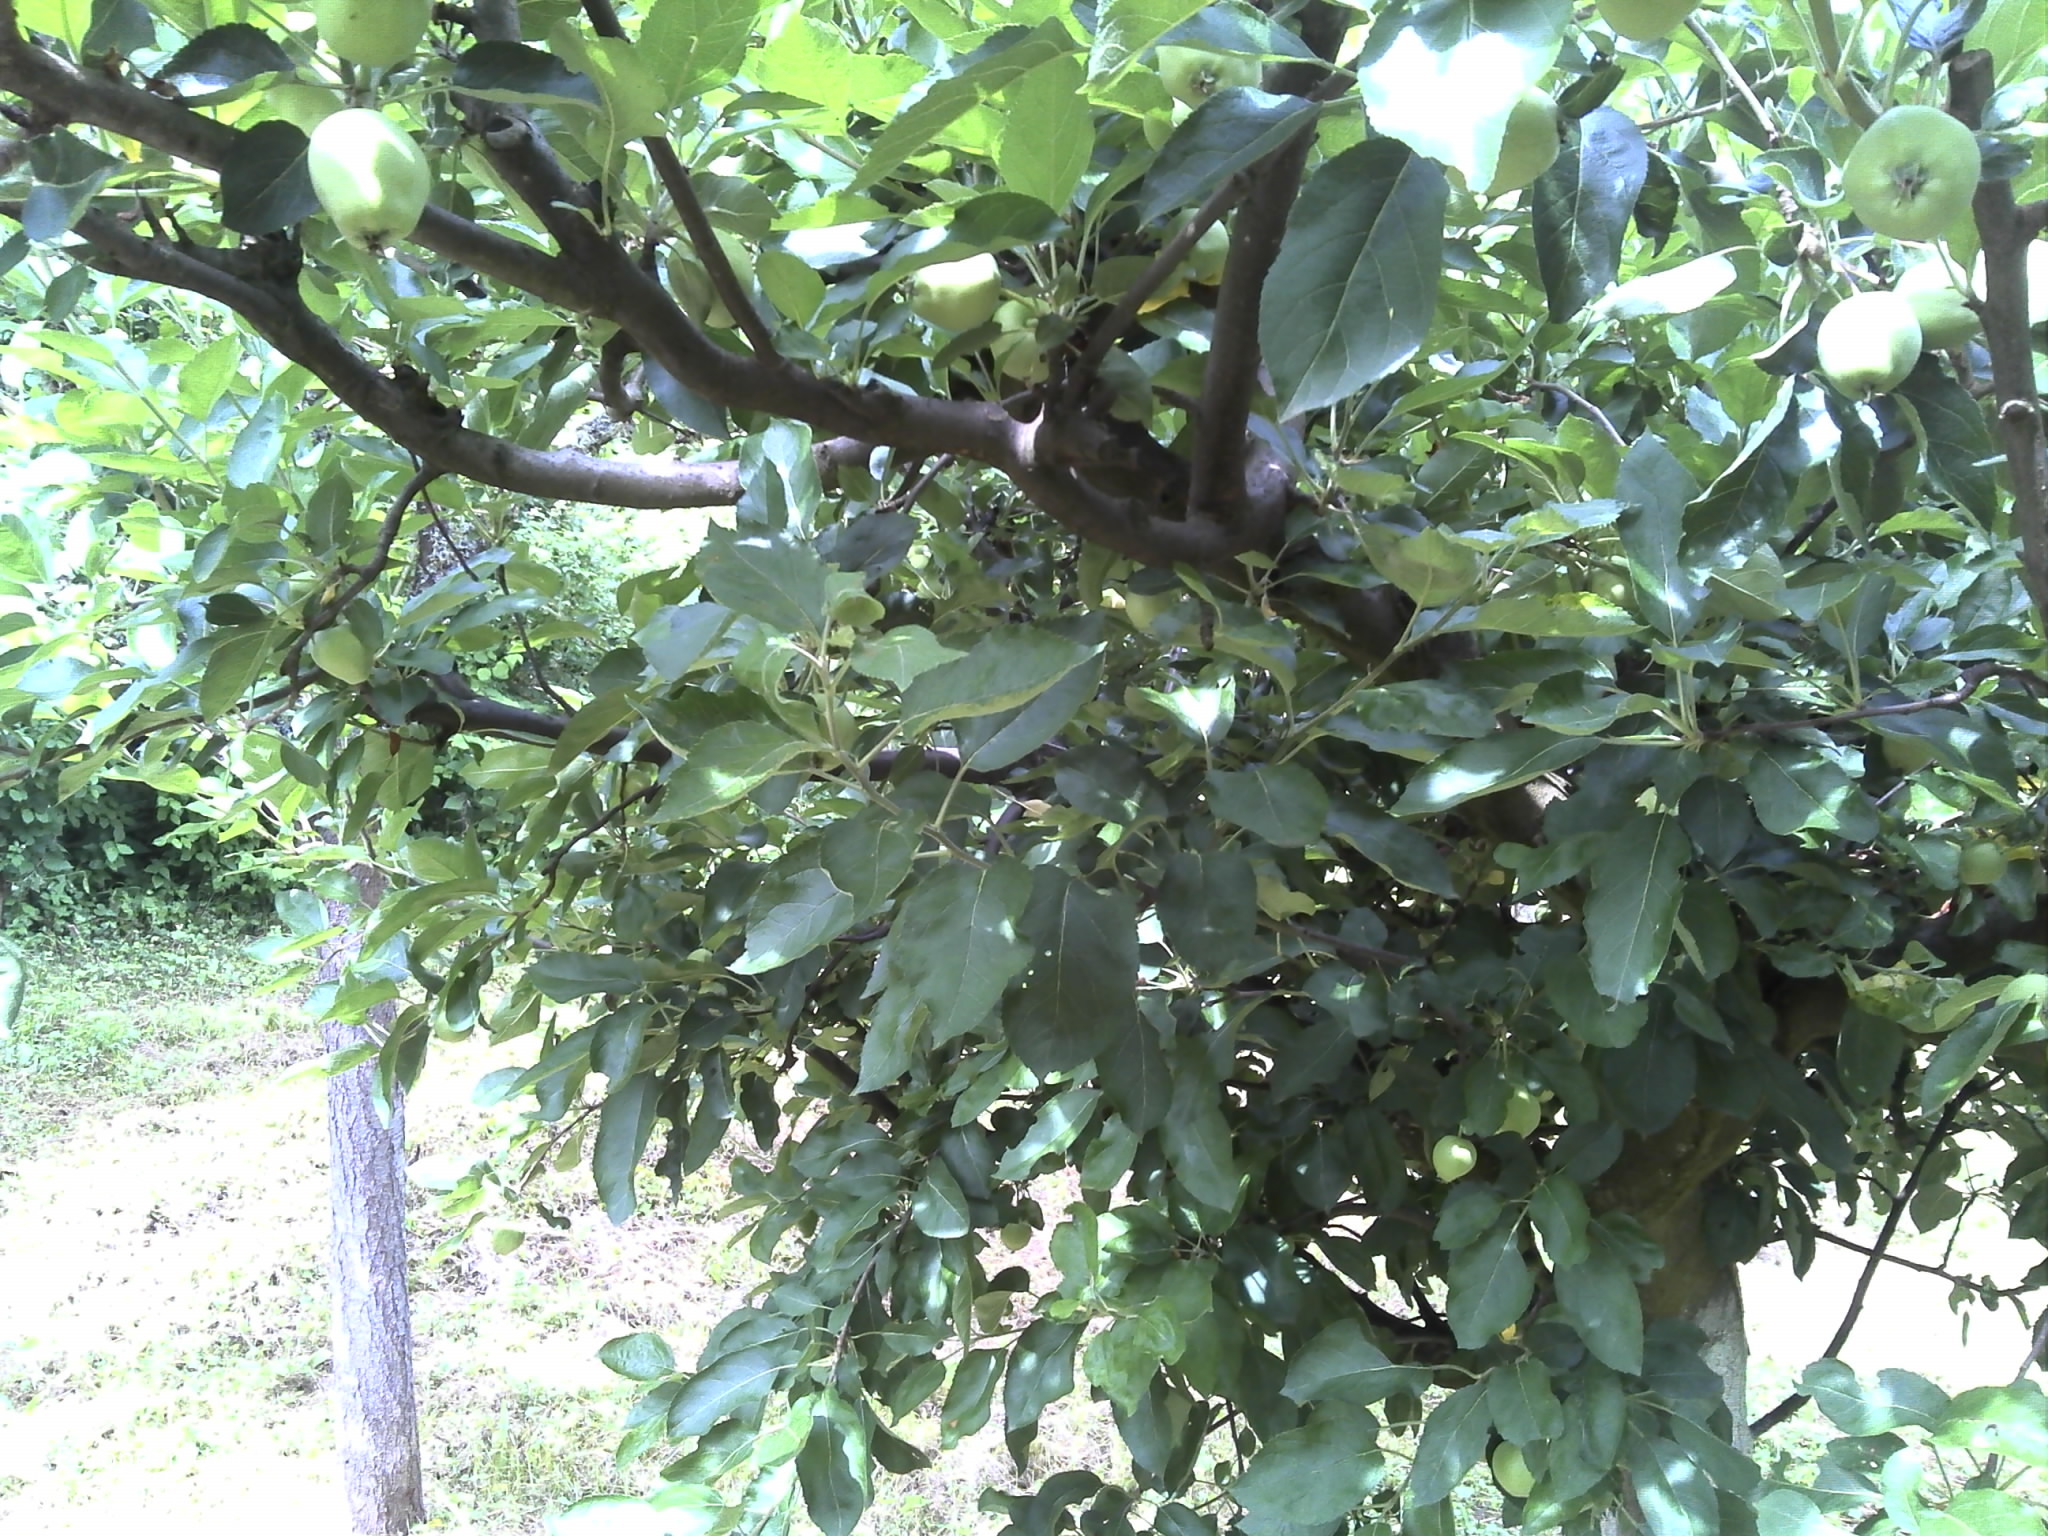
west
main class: Cropland
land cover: Apple fruit
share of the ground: > 75 %
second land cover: Grassland without tree/shrub cover
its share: > 75 %
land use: Agriculture (excluding fallow land and kitchen gardens)
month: June
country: HR
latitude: 45.3231
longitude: 17.5665
